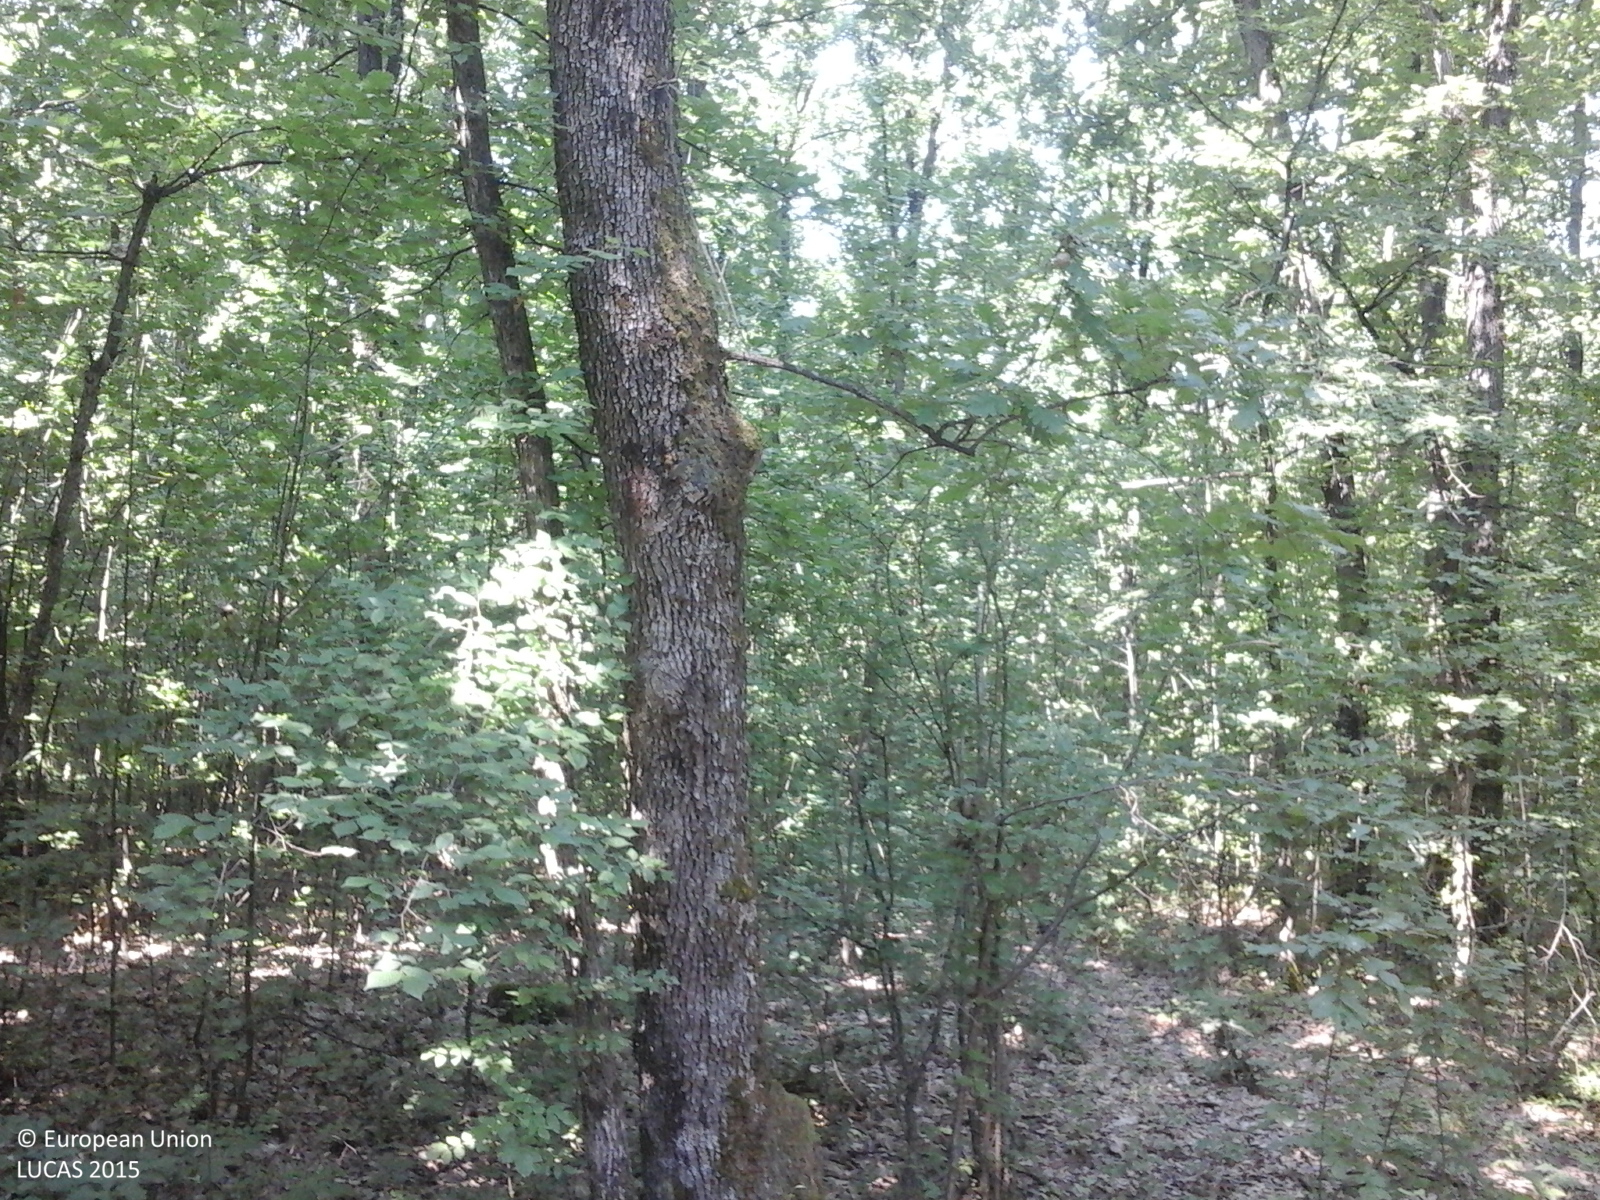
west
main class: Woodland
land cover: Broadleaved woodland
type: beech forest
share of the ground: > 75 %
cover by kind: broadleaved forest trees 100 %
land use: Forestry
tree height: > 5 m
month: July
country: RO
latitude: 44.7336
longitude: 24.3777
